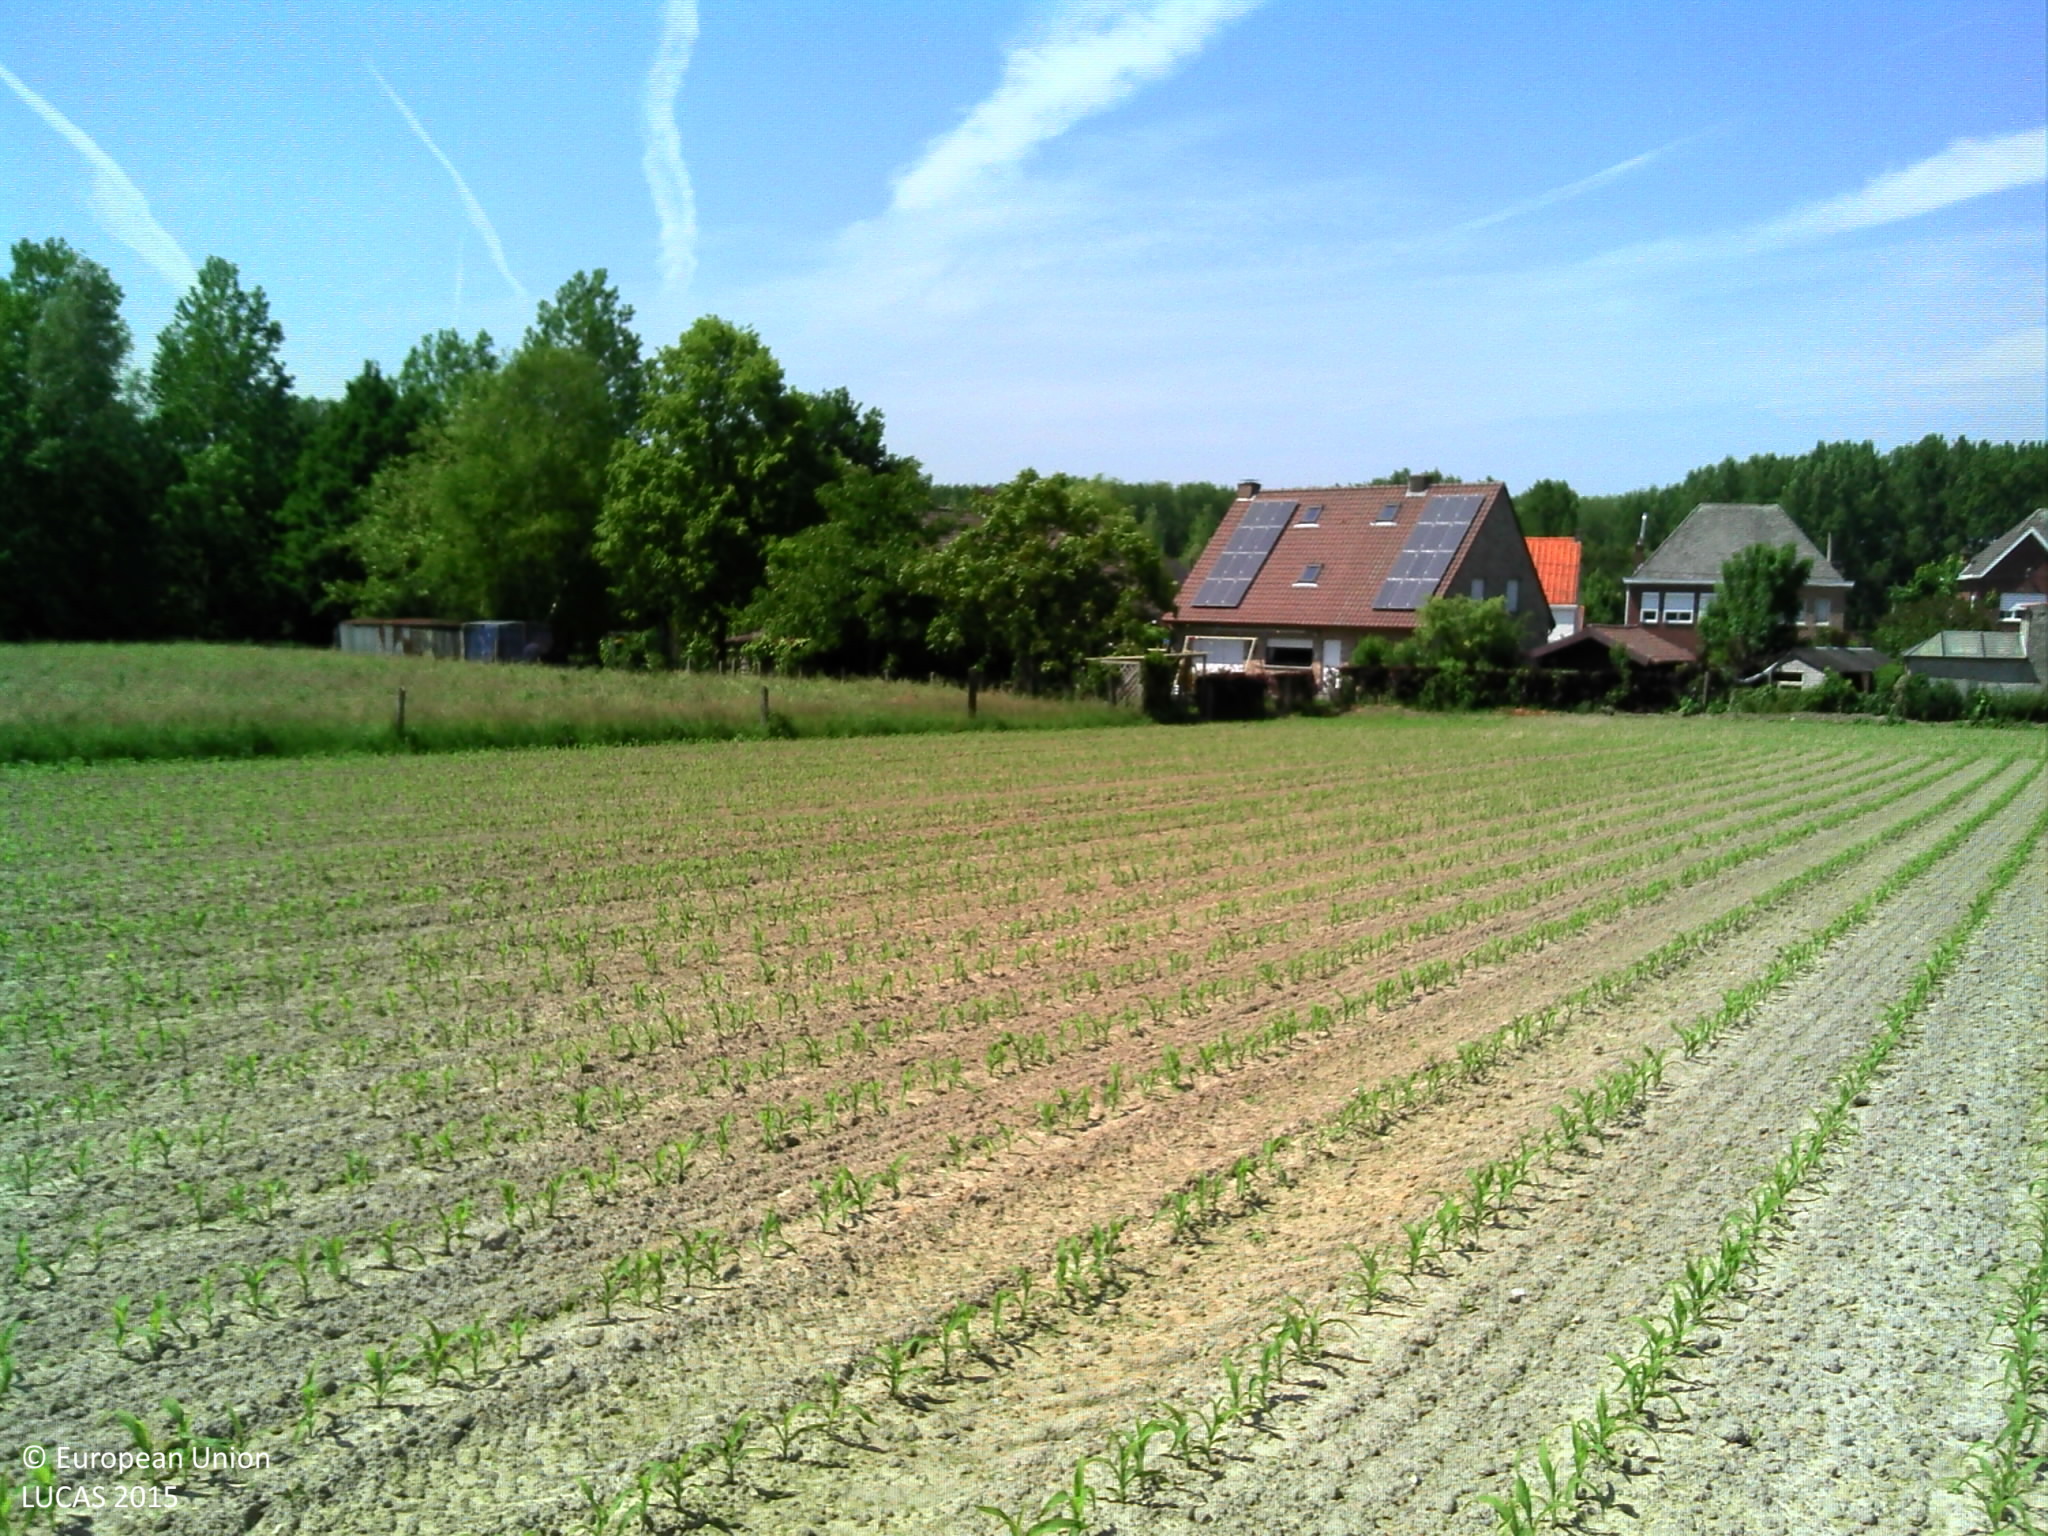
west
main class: Cropland
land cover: Maize
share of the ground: 10 - 25 %
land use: Agriculture (excluding fallow land and kitchen gardens)
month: June
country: BE
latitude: 50.9712
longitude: 3.7986
